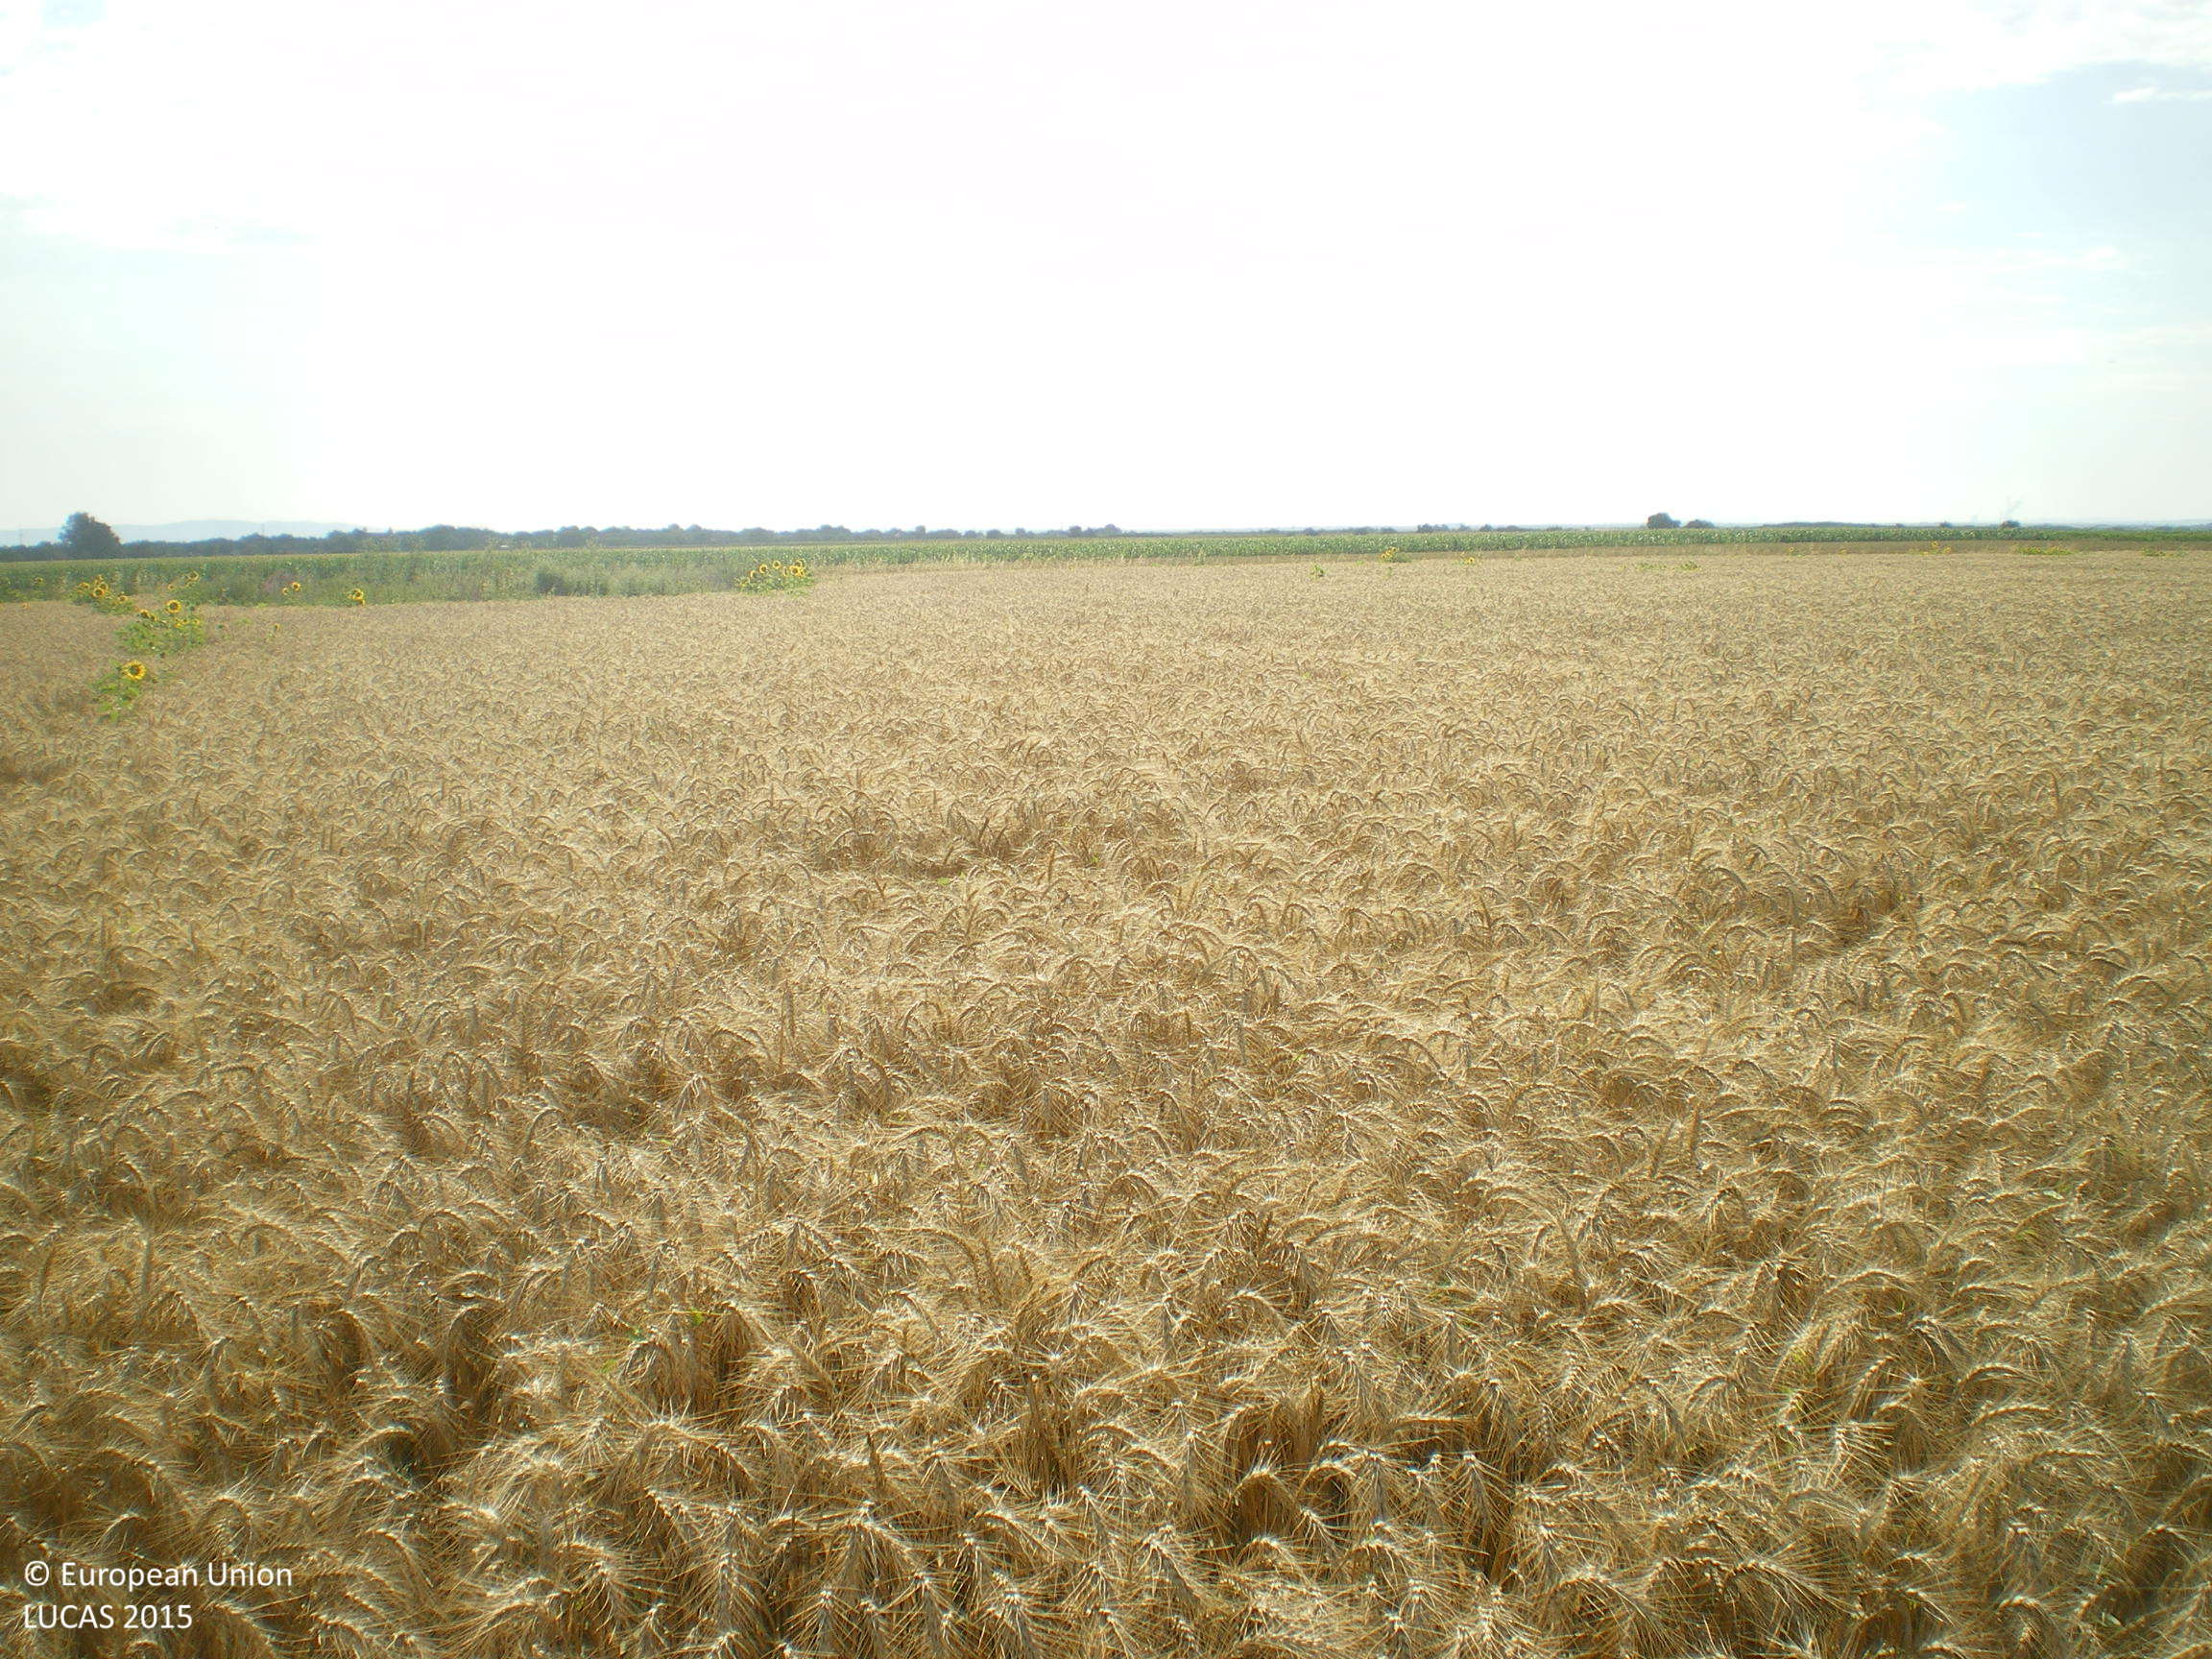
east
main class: Cropland
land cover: Barley
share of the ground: > 75 %
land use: Agriculture (excluding fallow land and kitchen gardens)
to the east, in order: Barley; Spontaneously vegetated surfaces; Maize
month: July
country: BG
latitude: 42.3702
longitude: 25.8502
